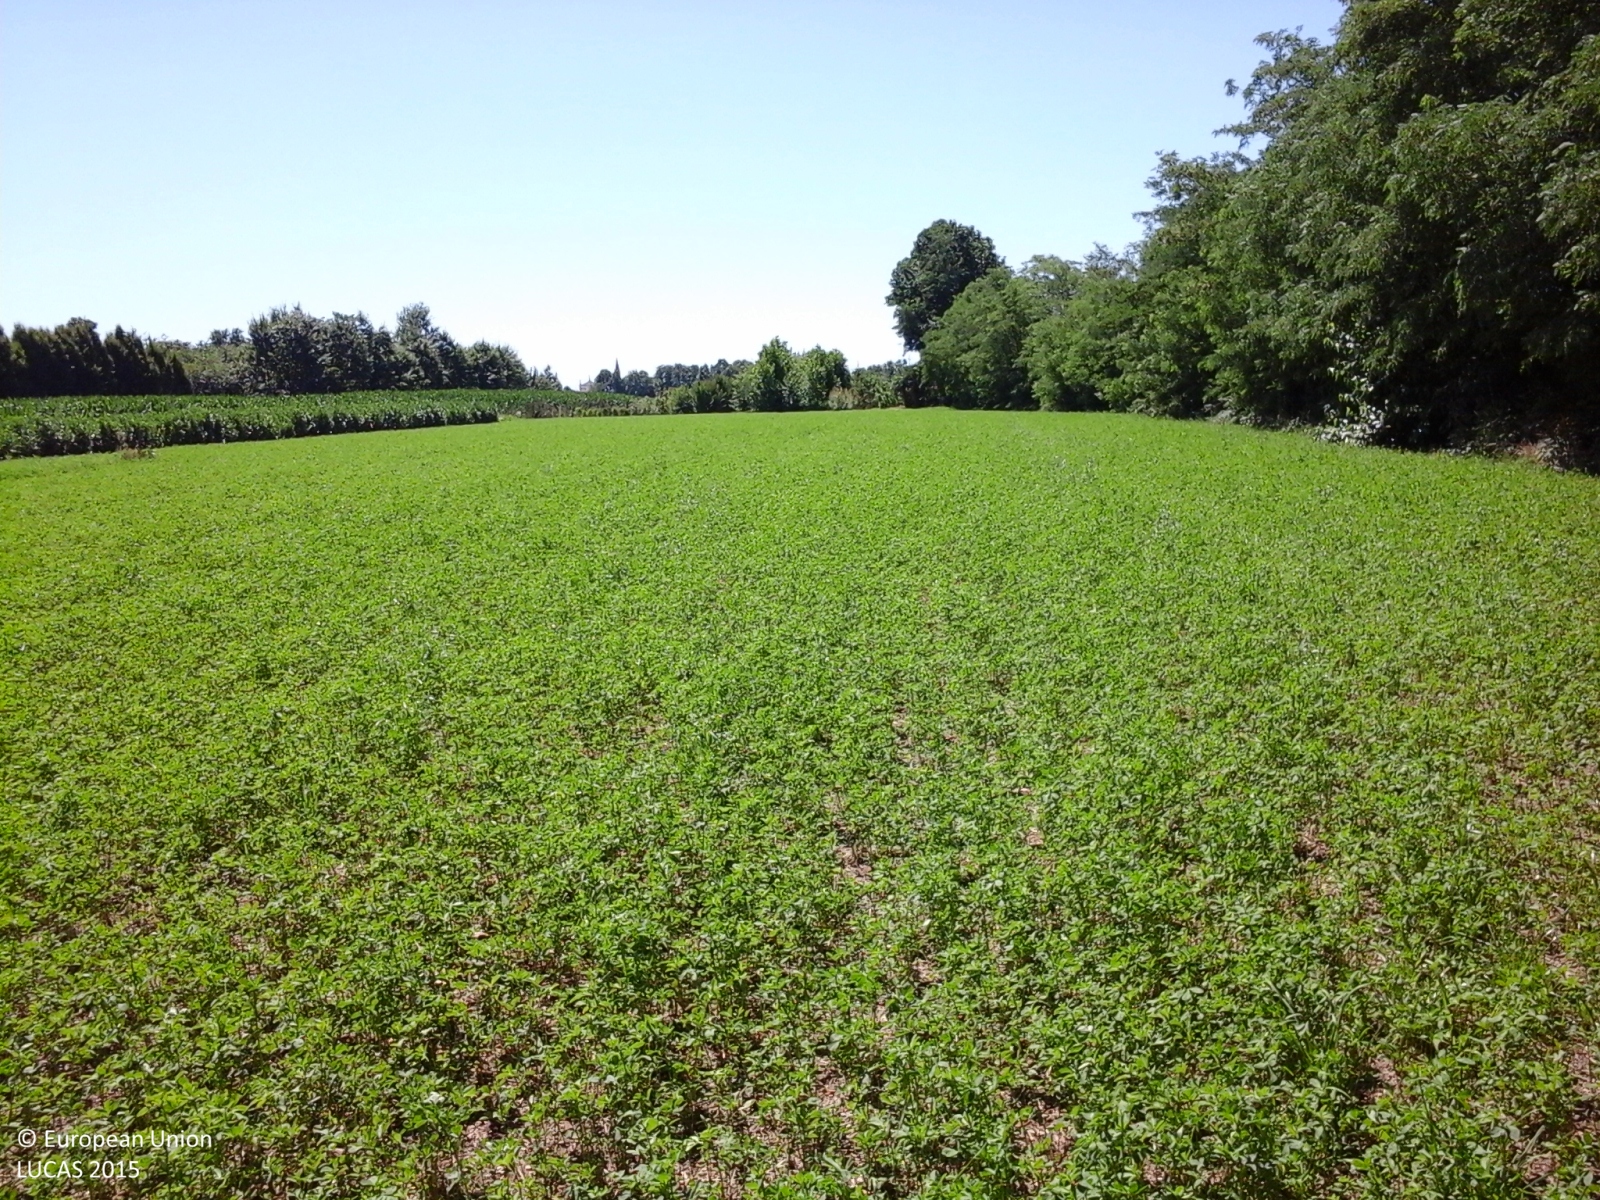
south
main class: Cropland
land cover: Lucerne
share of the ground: > 75 %
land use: Agriculture (excluding fallow land and kitchen gardens)
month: June
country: IT
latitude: 45.7223
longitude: 11.8602
